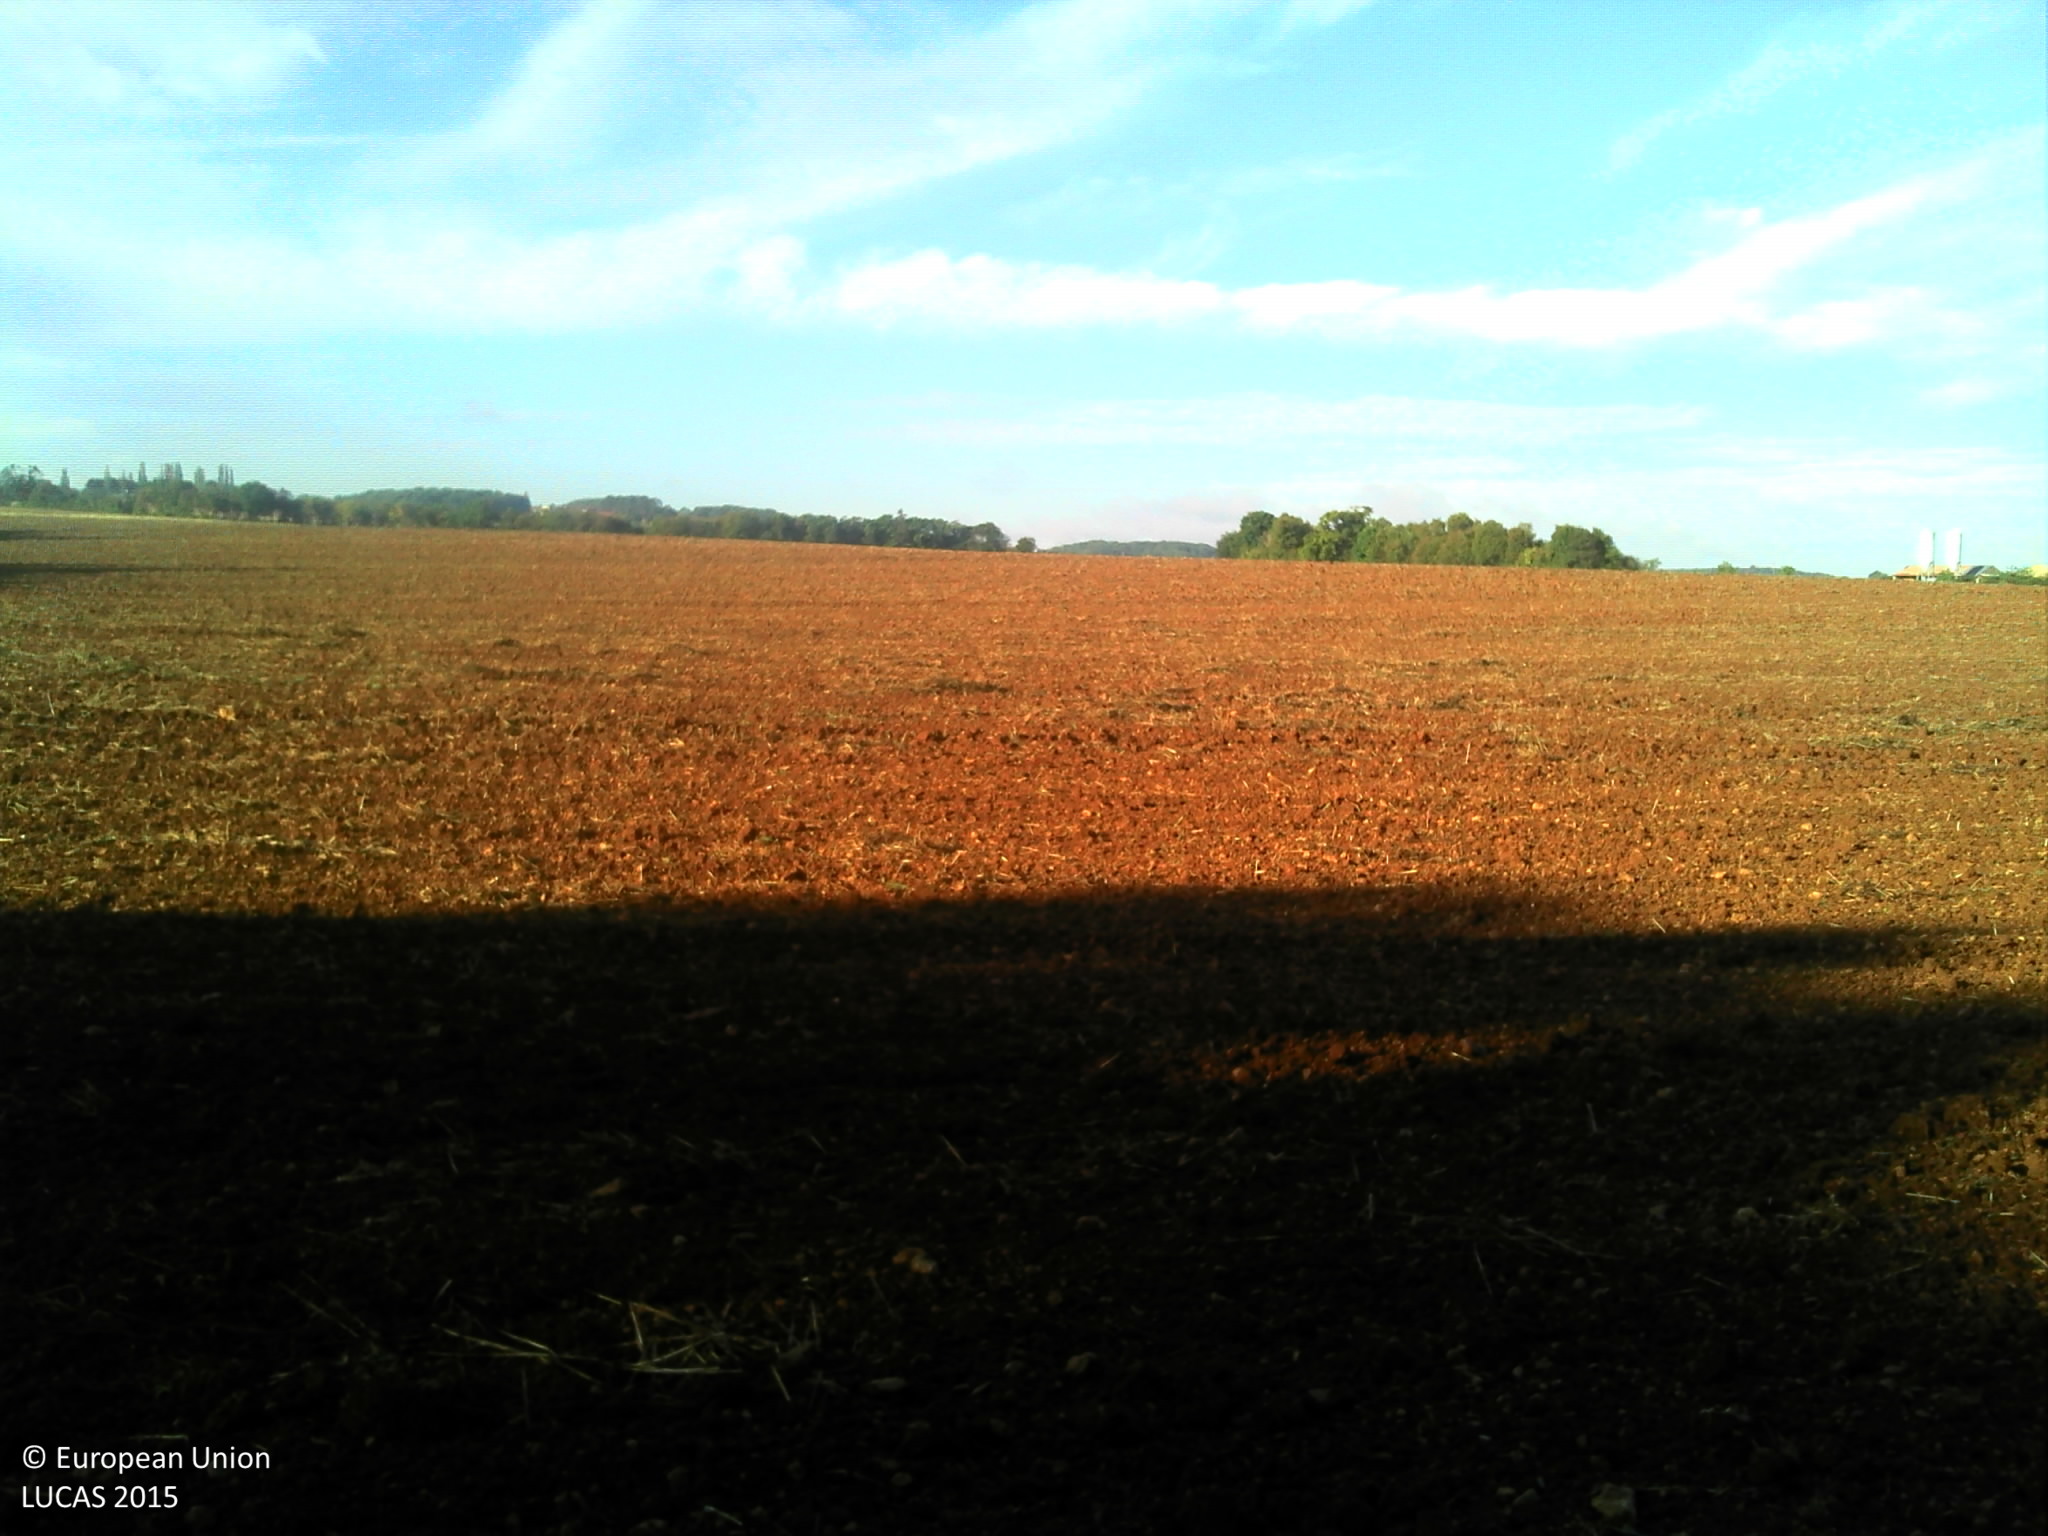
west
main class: Cropland
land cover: Common wheat
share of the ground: < 10 %
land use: Agriculture (excluding fallow land and kitchen gardens)
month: September
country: FR
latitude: 48.6732
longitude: 5.9937
